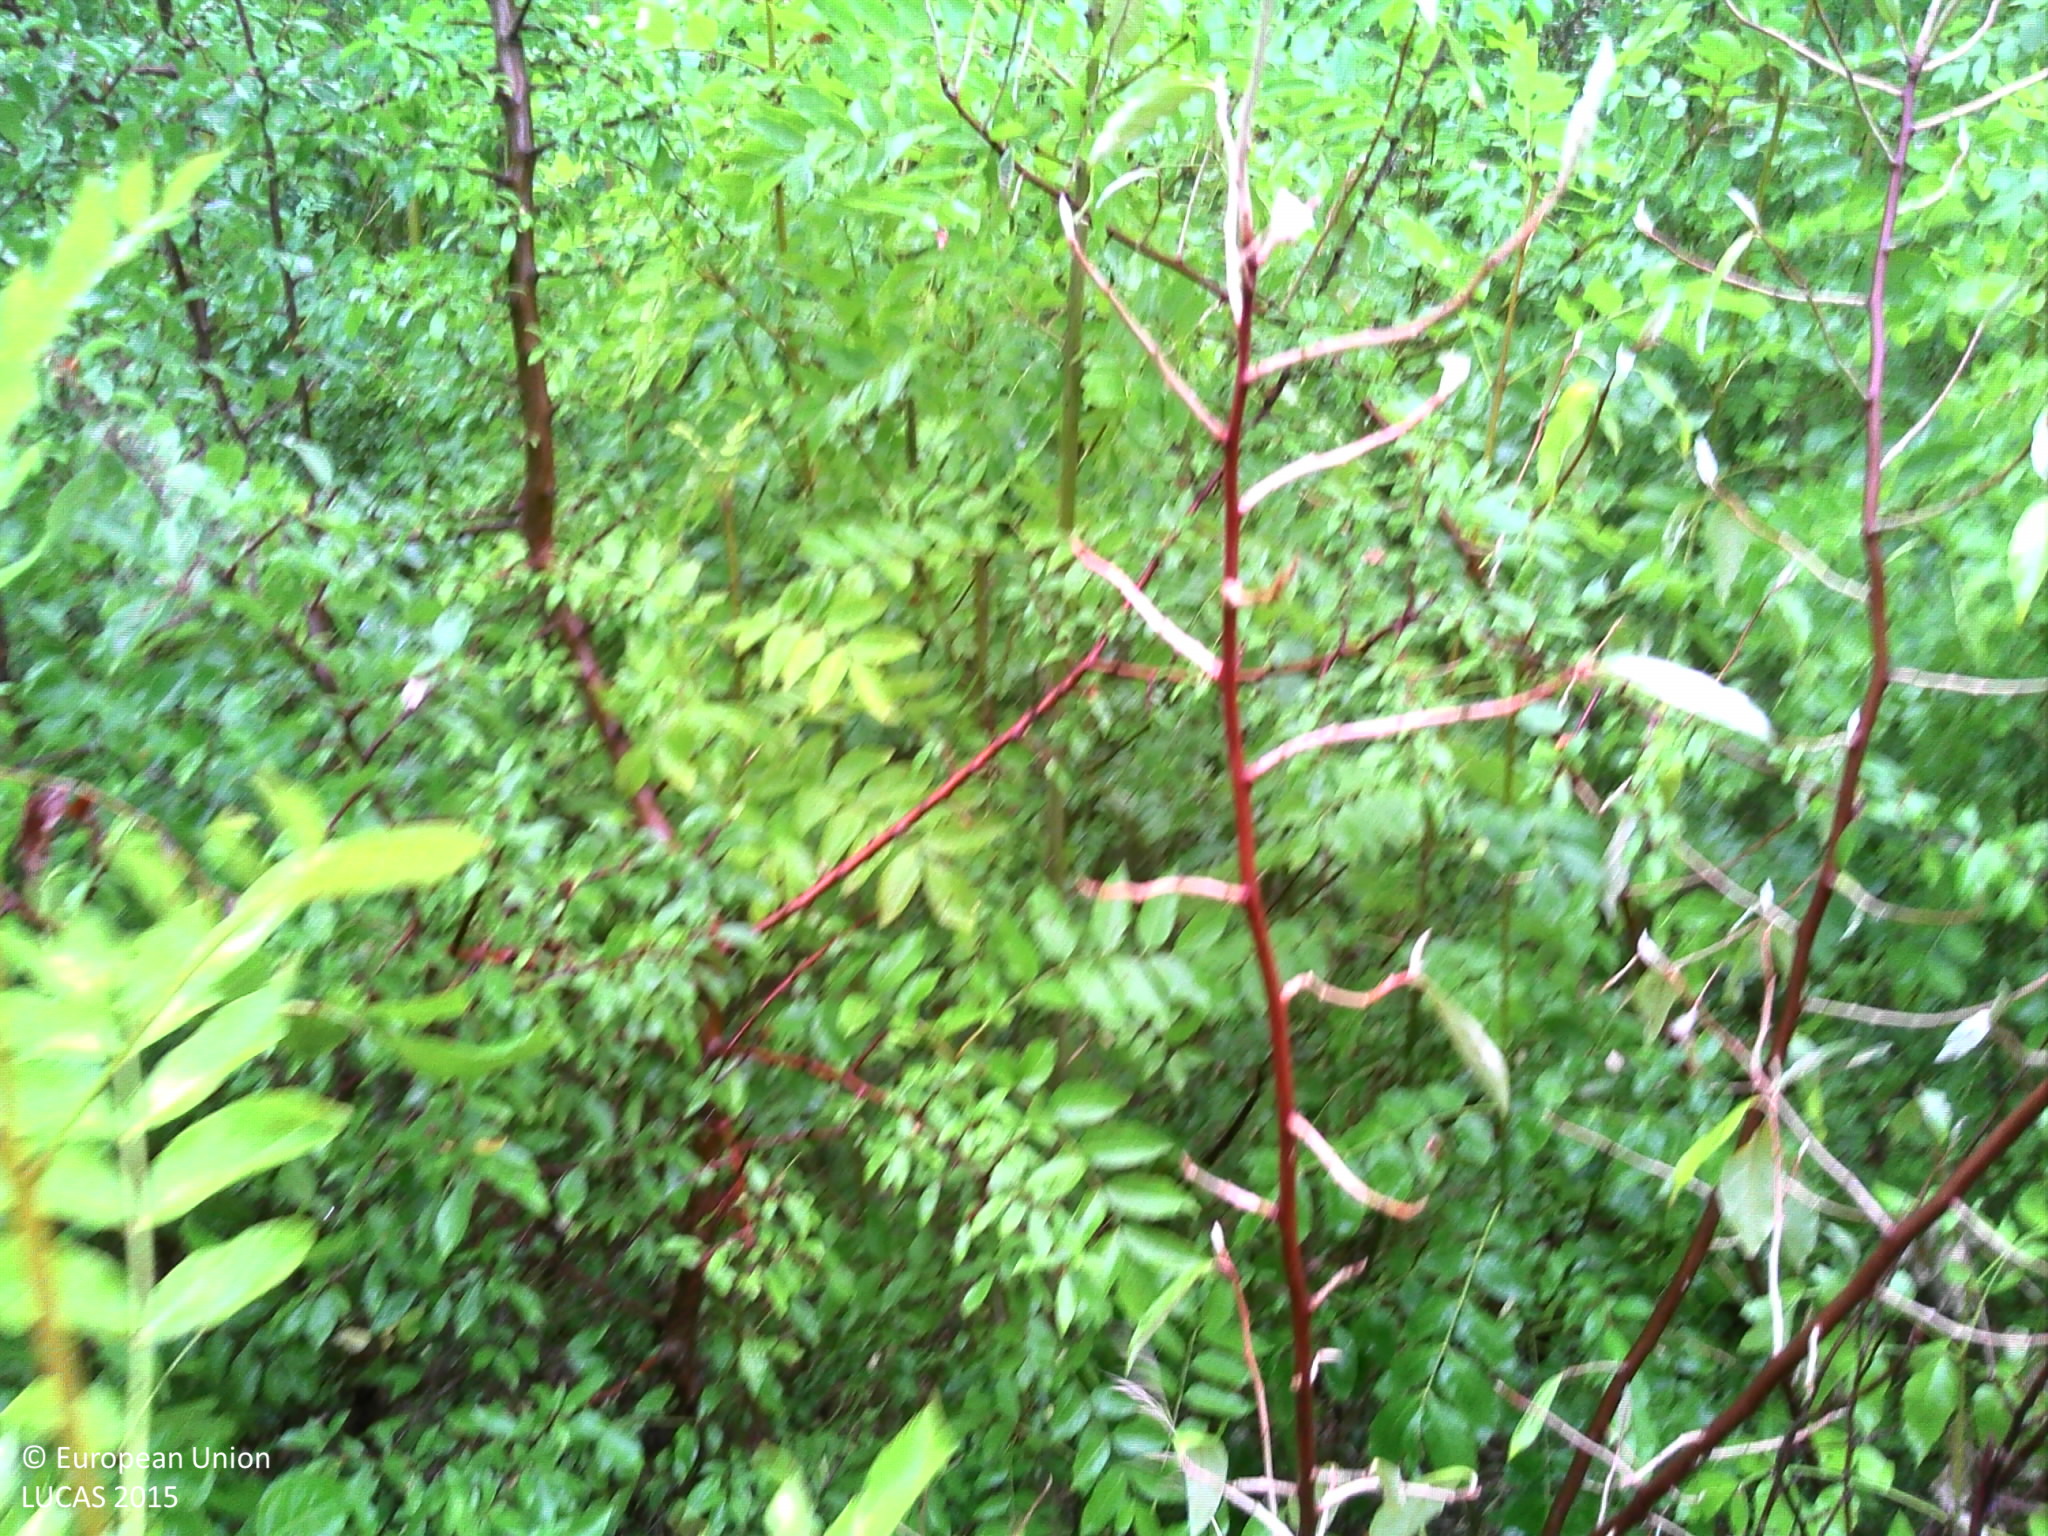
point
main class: Woodland
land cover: Broadleaved woodland
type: mesophytic deciduous forest
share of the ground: > 75 %
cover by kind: broadleaved forest trees 100 %
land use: Forestry
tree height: > 5 m
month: July
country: FR
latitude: 47.8429
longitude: 2.0110
